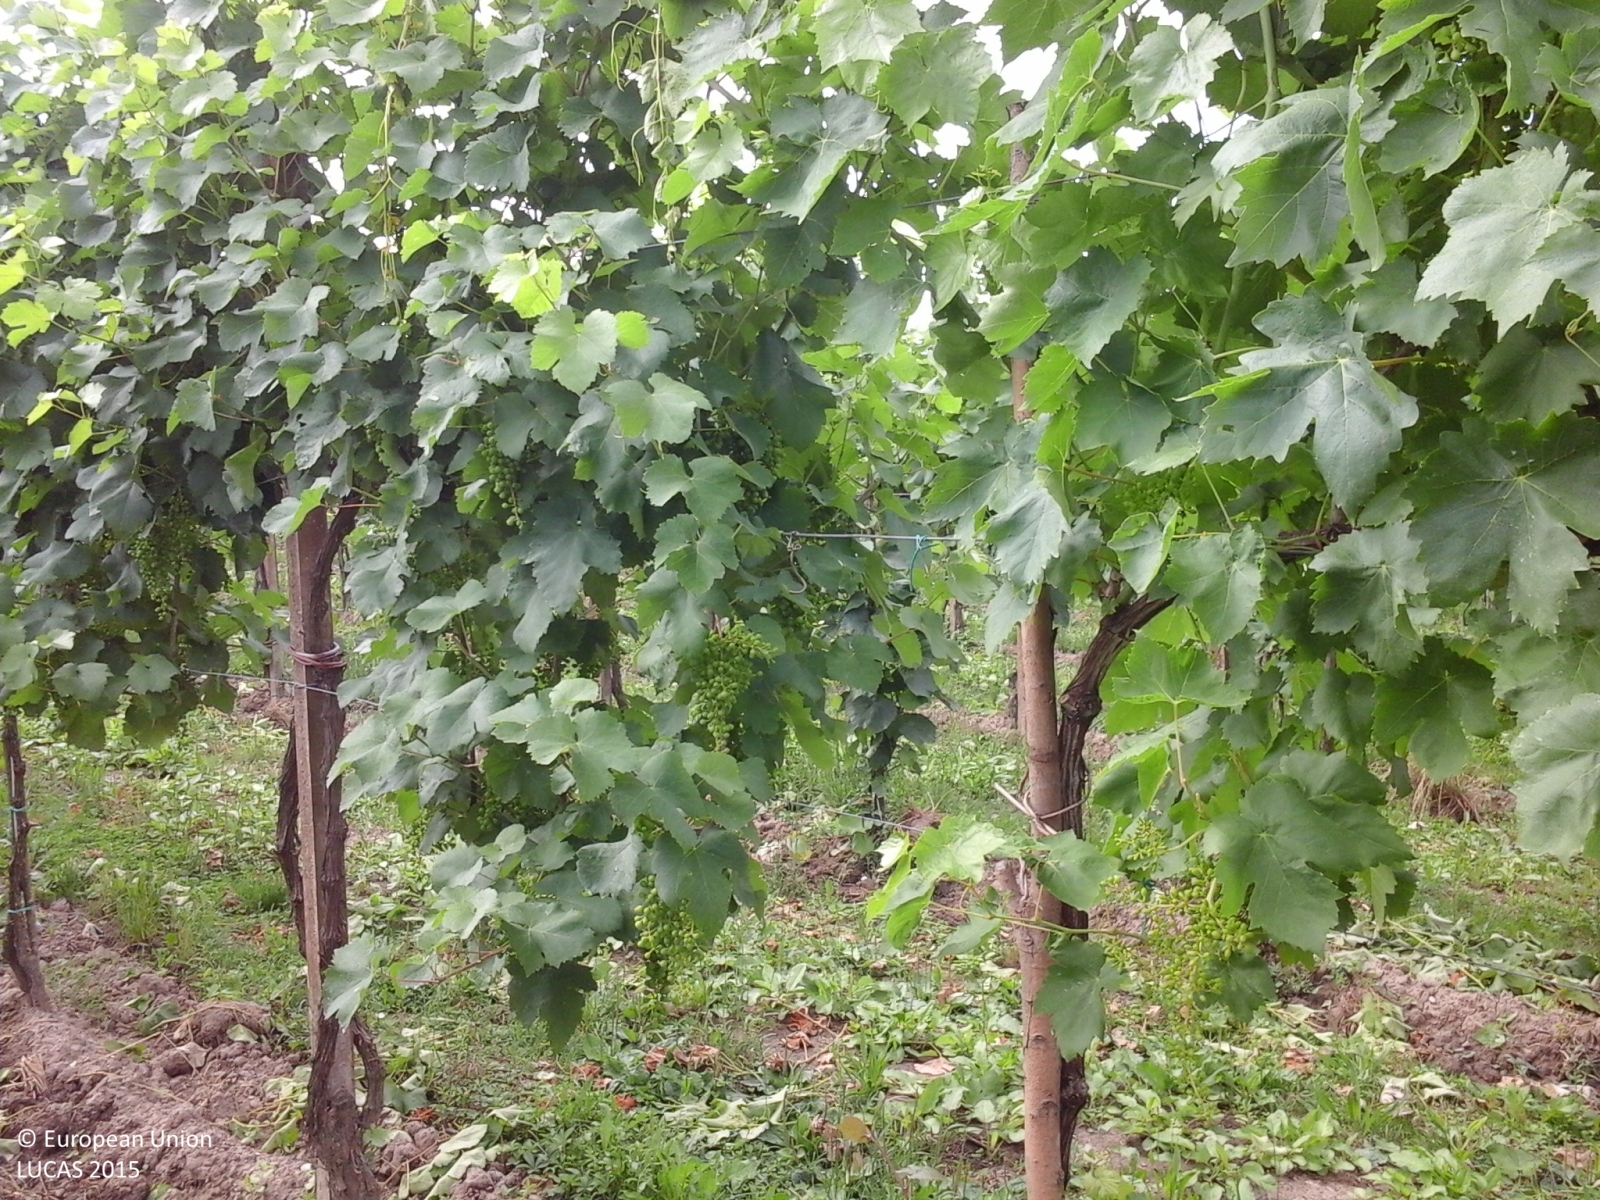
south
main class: Cropland
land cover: Vineyards
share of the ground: 25 - 50 %
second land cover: Grassland without tree/shrub cover
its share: > 75 %
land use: Agriculture (excluding fallow land and kitchen gardens)
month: June
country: IT
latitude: 45.6906
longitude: 12.5261
